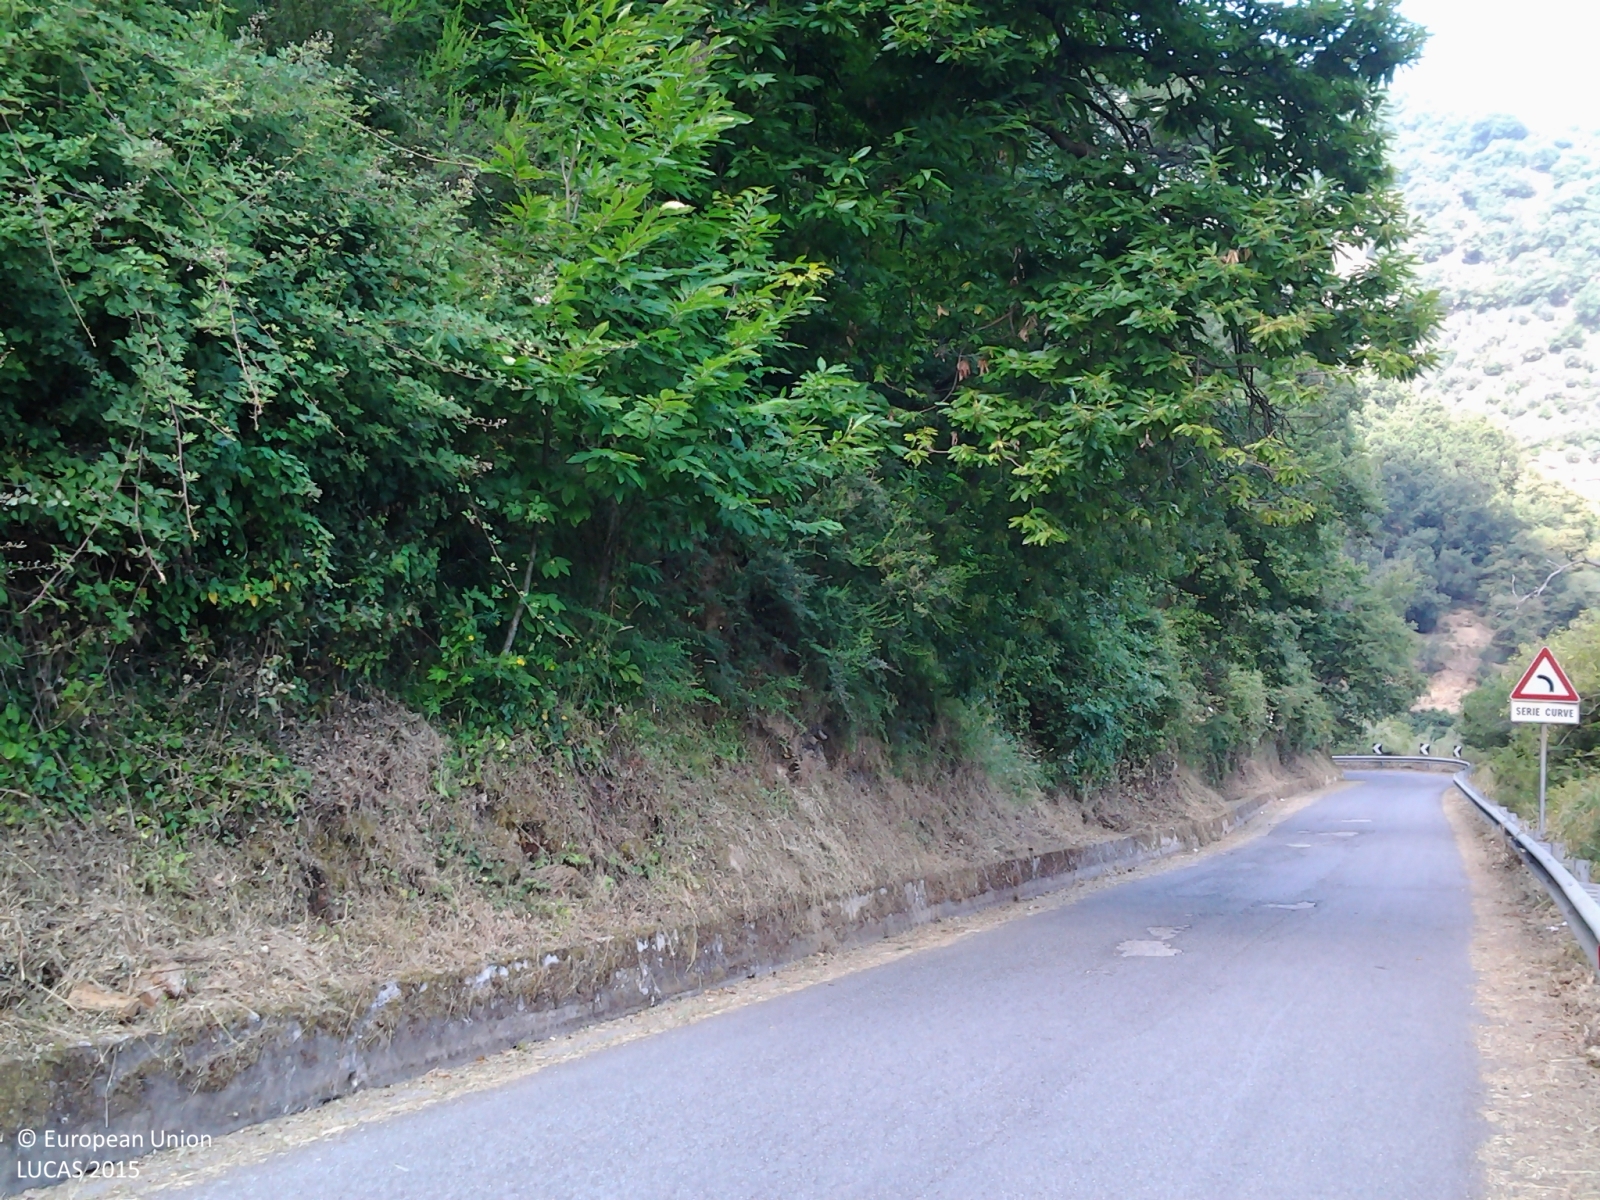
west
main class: Shrubland
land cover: Shrubland with sparse tree cover
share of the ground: > 75 %
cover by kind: shrubs 85 %, broadleaved forest trees 5 %, herbaceous plants 5 %
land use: Semi-natural and natural areas not in use
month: July
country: IT
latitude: 38.1298
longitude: 14.9075
